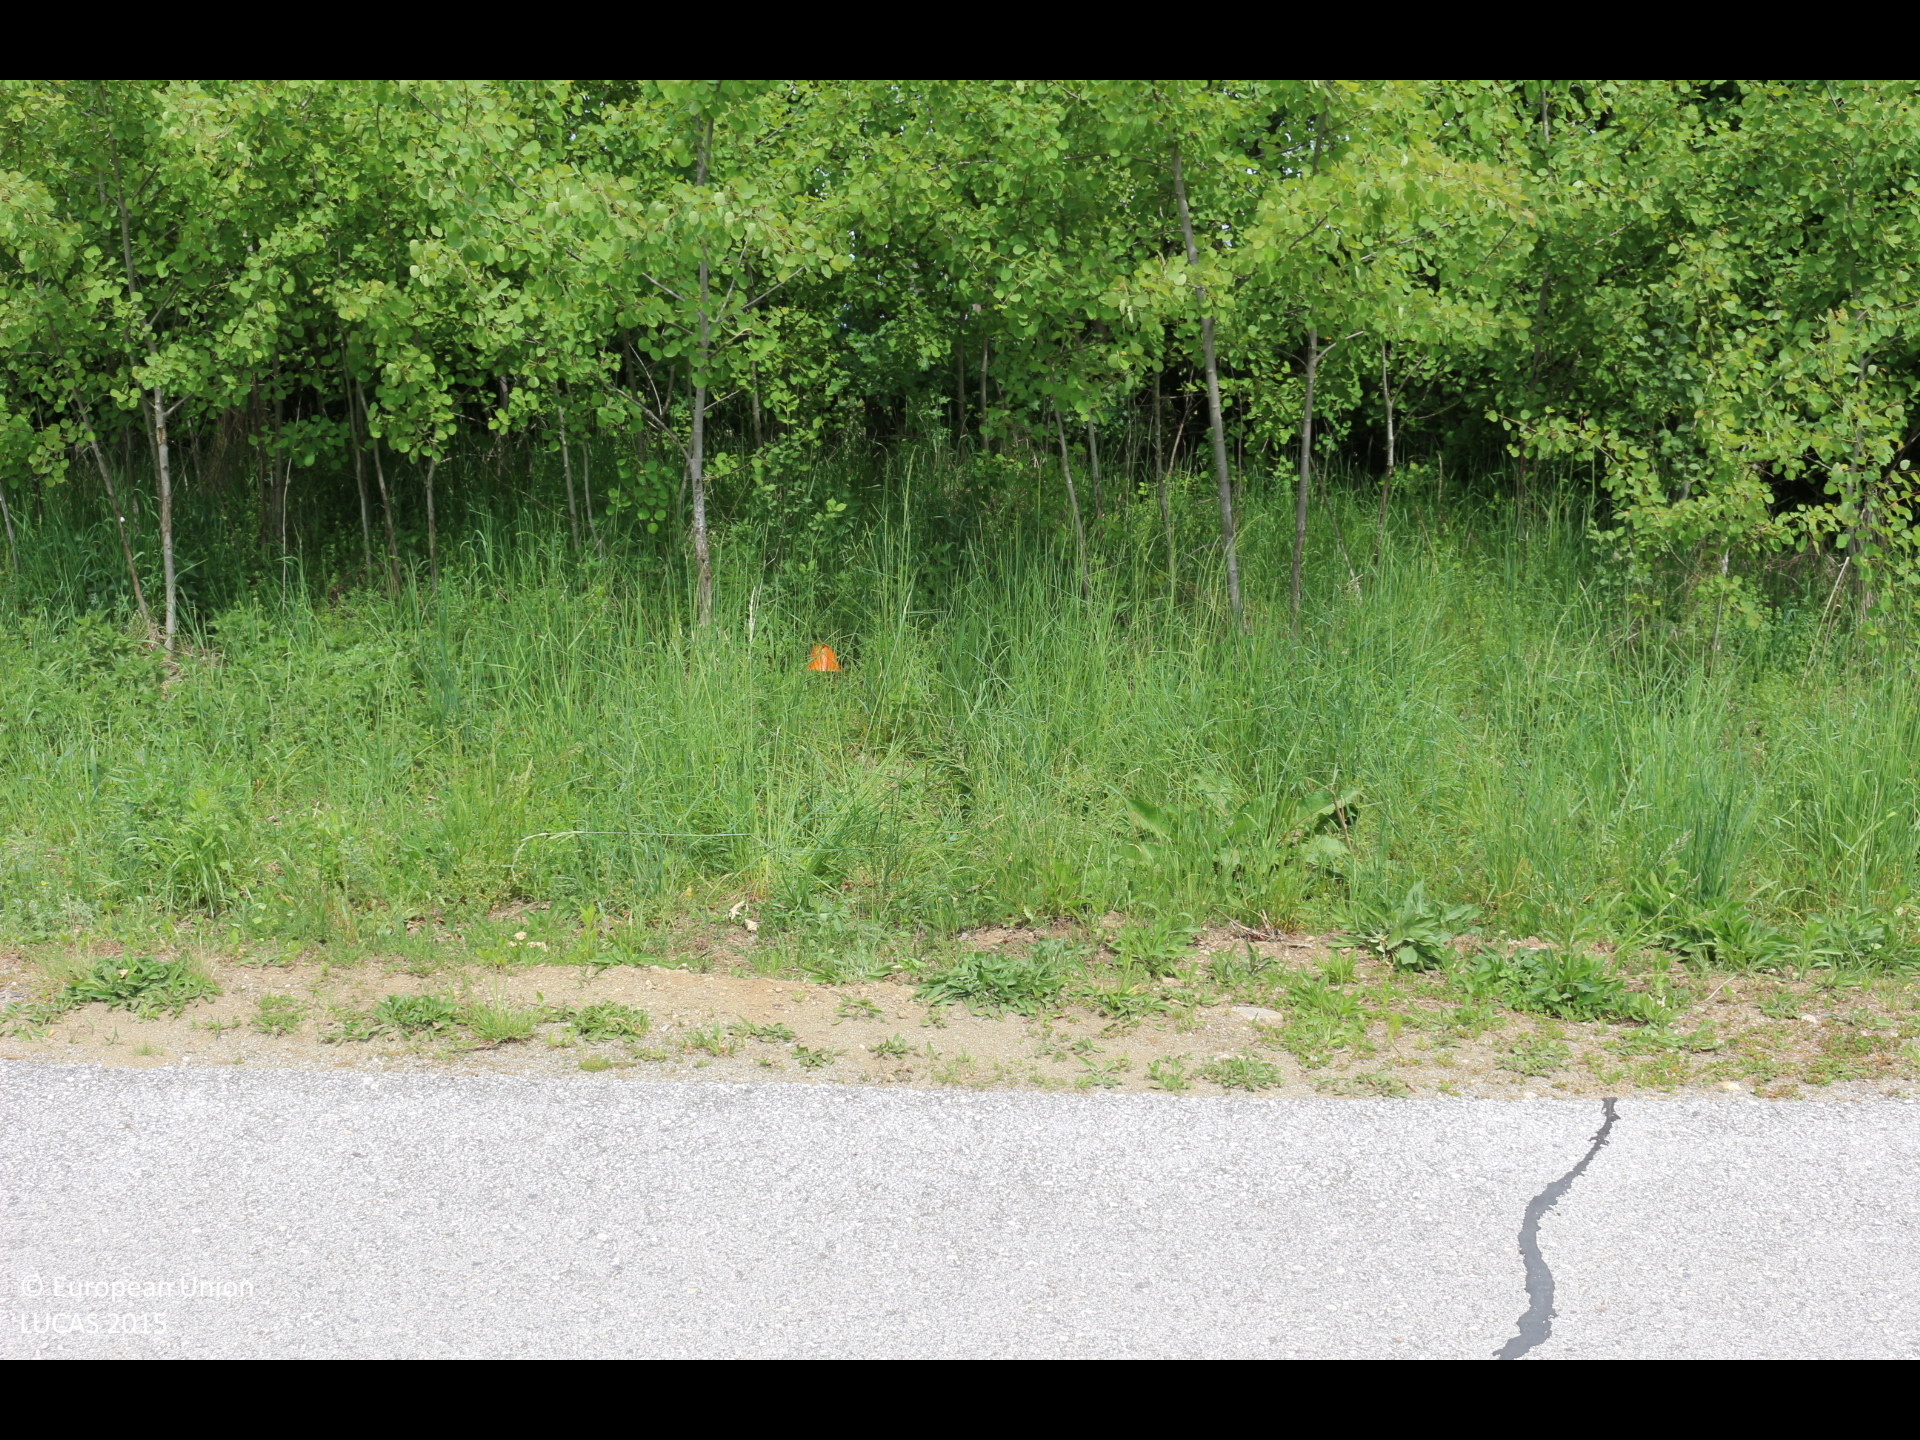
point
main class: Woodland
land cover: Broadleaved woodland
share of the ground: > 75 %
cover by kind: broadleaved forest trees 80 %, shrubs 10 %, herbaceous plants 10 %
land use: Railway transport
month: May
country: AT
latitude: 46.6204
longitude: 14.4246
